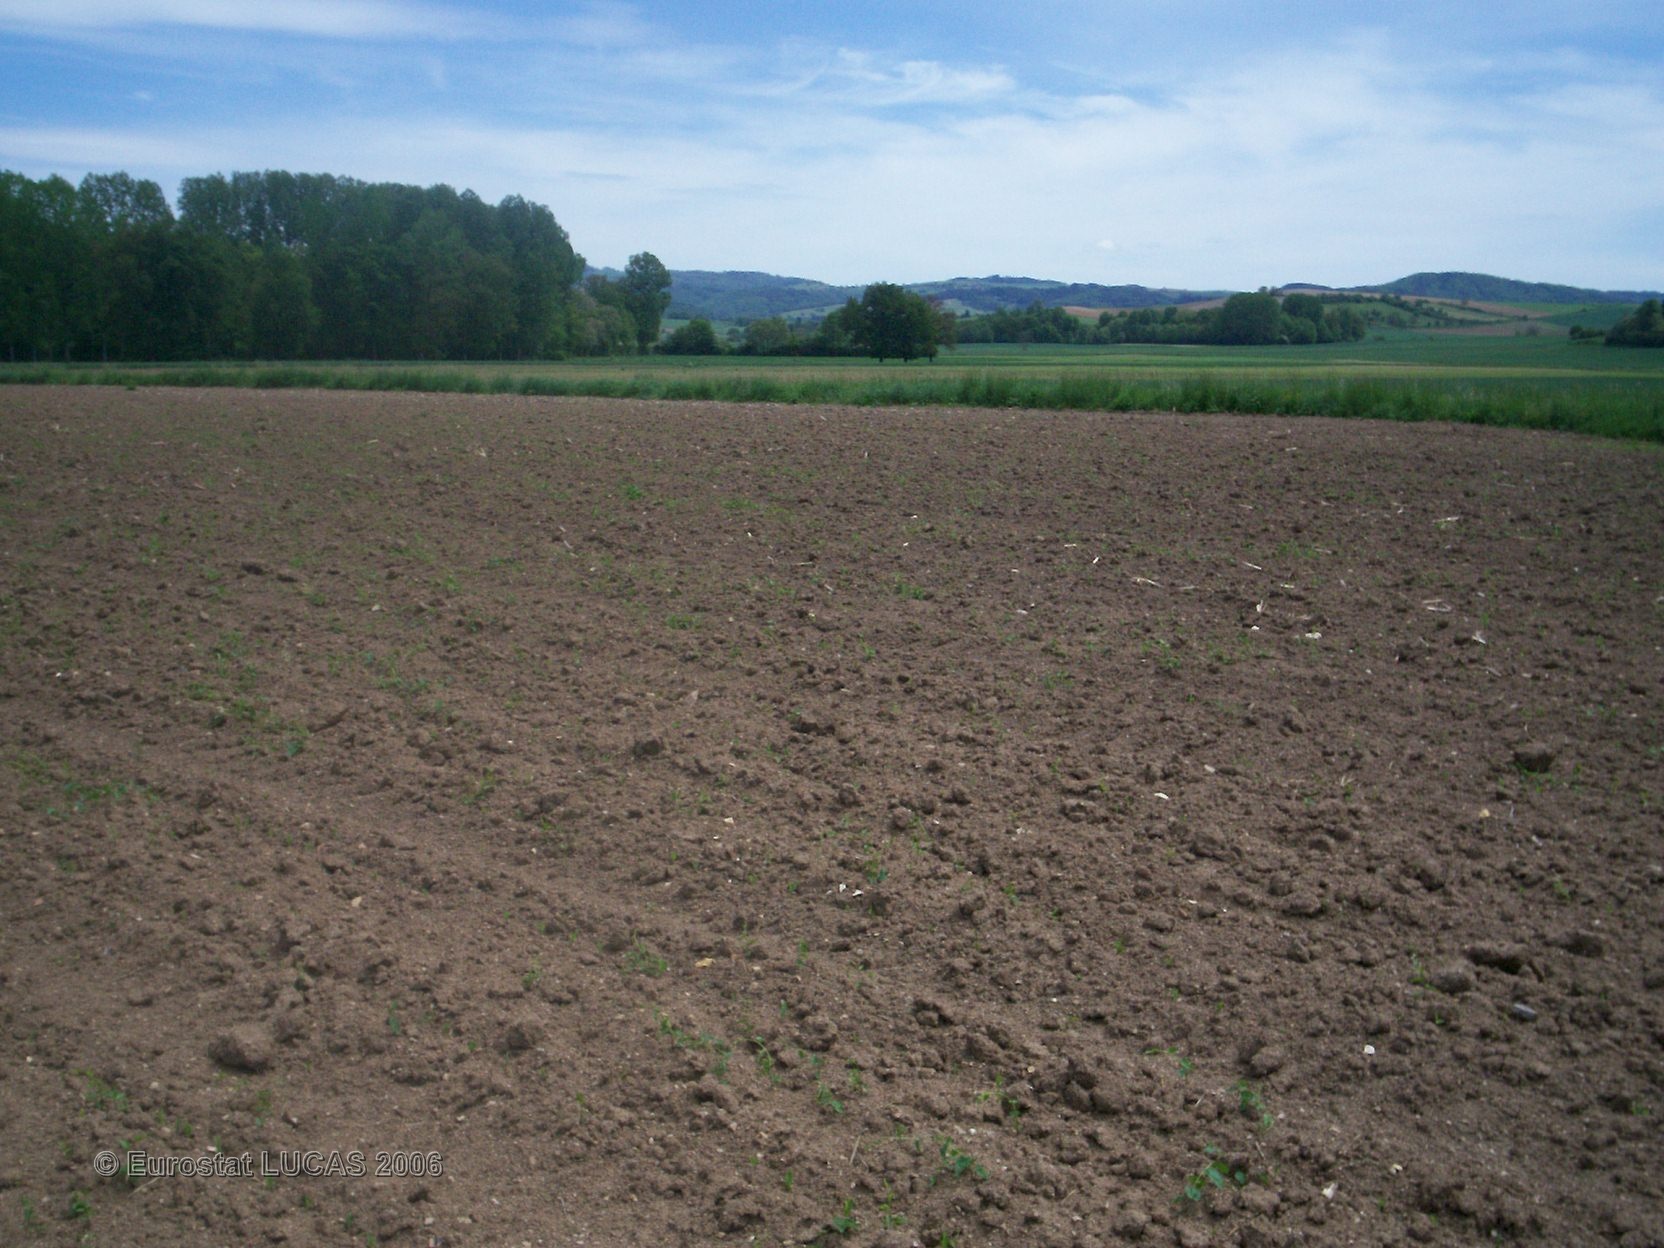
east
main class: Cropland
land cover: Maize
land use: Agriculture (excluding fallow land and kitchen gardens)
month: May
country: FR
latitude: 45.5089
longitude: 3.3070
